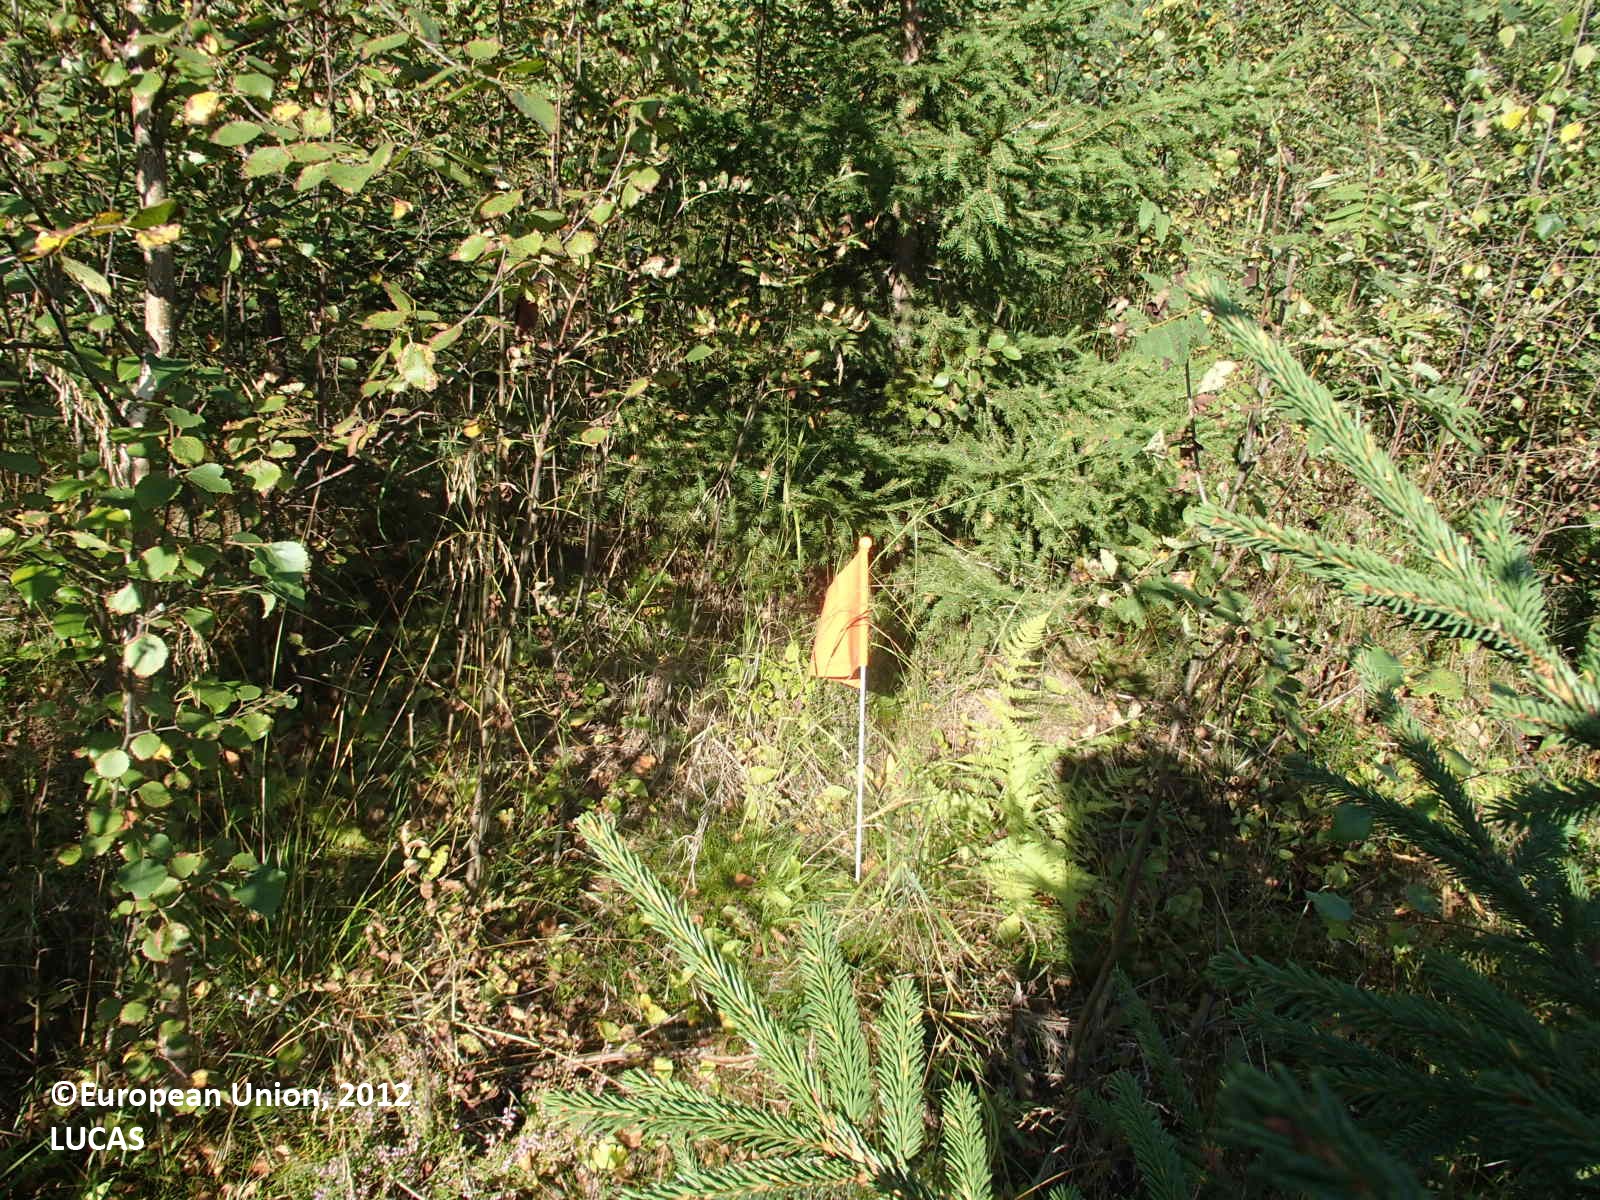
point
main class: Woodland
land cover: Spruce dominated mixed woodland
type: boreal forest
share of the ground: > 75 %
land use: Forestry
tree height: < 5 m
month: August
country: FI
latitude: 63.5529
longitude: 27.8982
